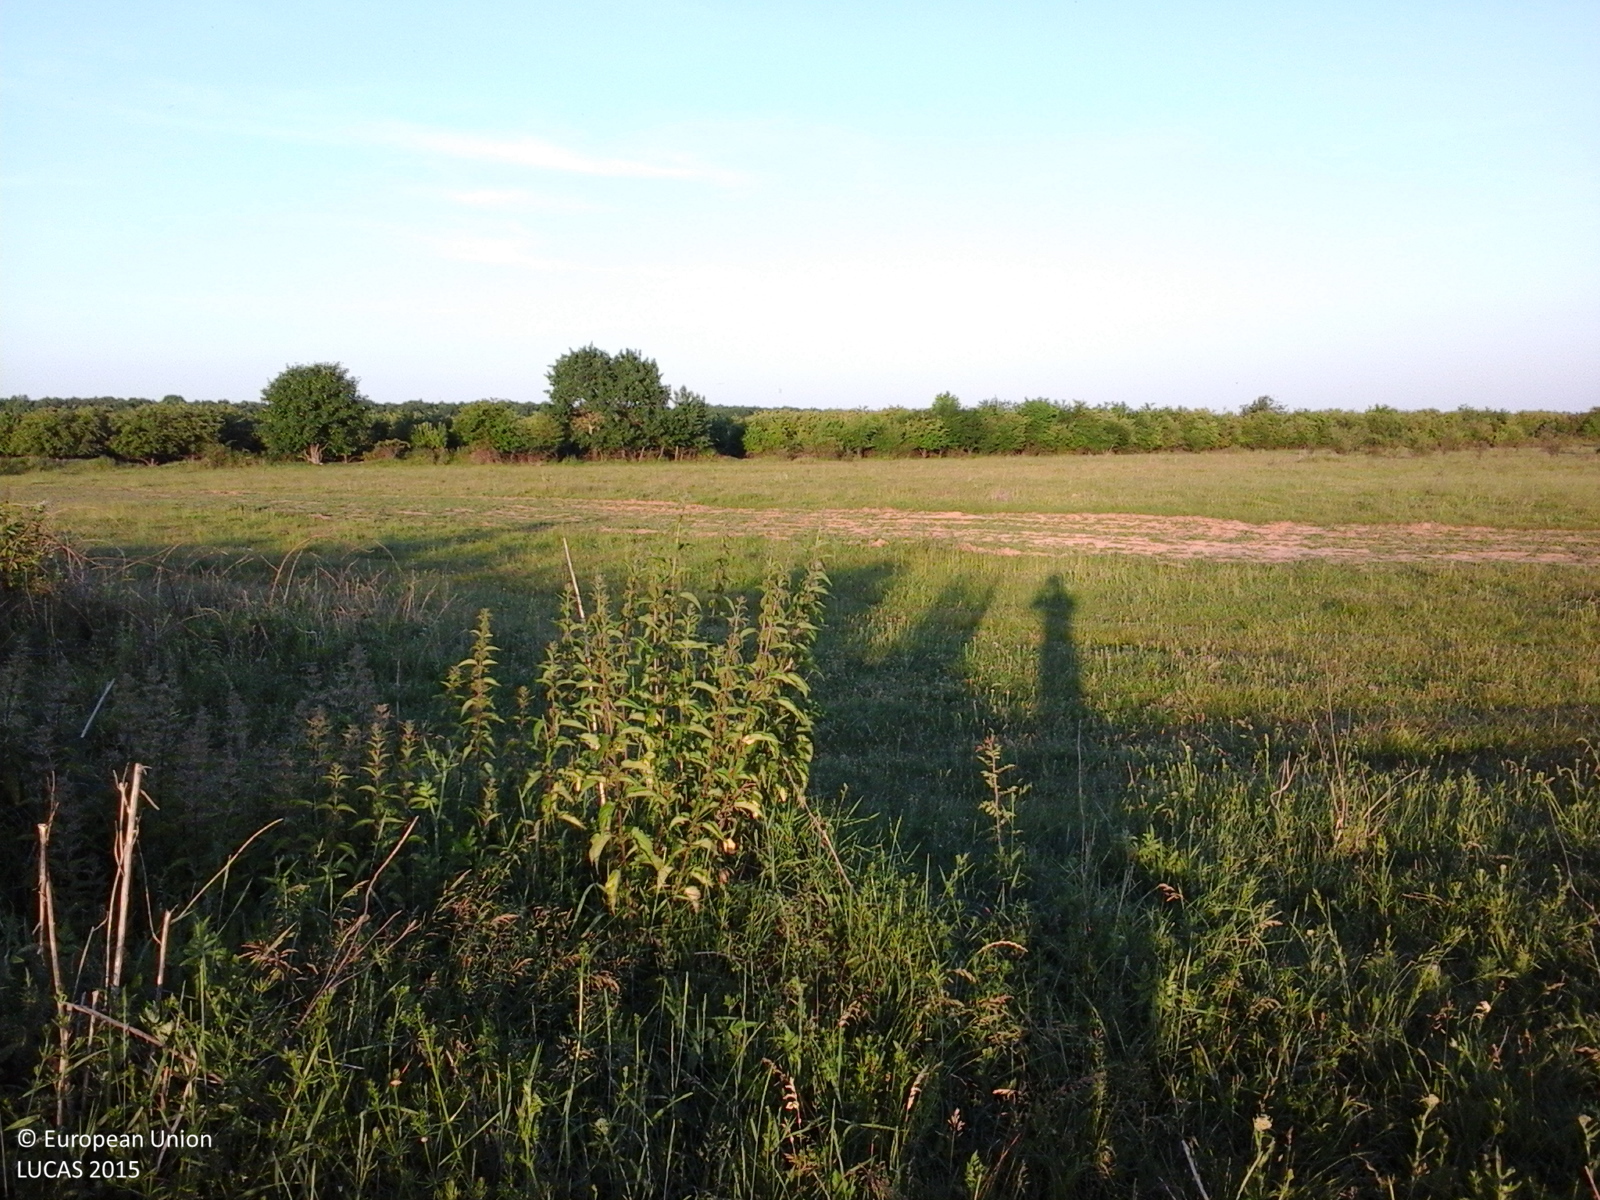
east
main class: Grassland
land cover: Grassland without tree/shrub cover
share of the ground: > 75 %
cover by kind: herbaceous plants 100 %
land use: Agriculture (excluding fallow land and kitchen gardens)
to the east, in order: Grassland without tree/shrub cover; Tracks; Grassland without tree/shrub cover; Abandoned hedges; Ditches and canals; Grassland without tree/shrub cover; Apple fruit
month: June
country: RO
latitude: 45.0732
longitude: 25.8169
